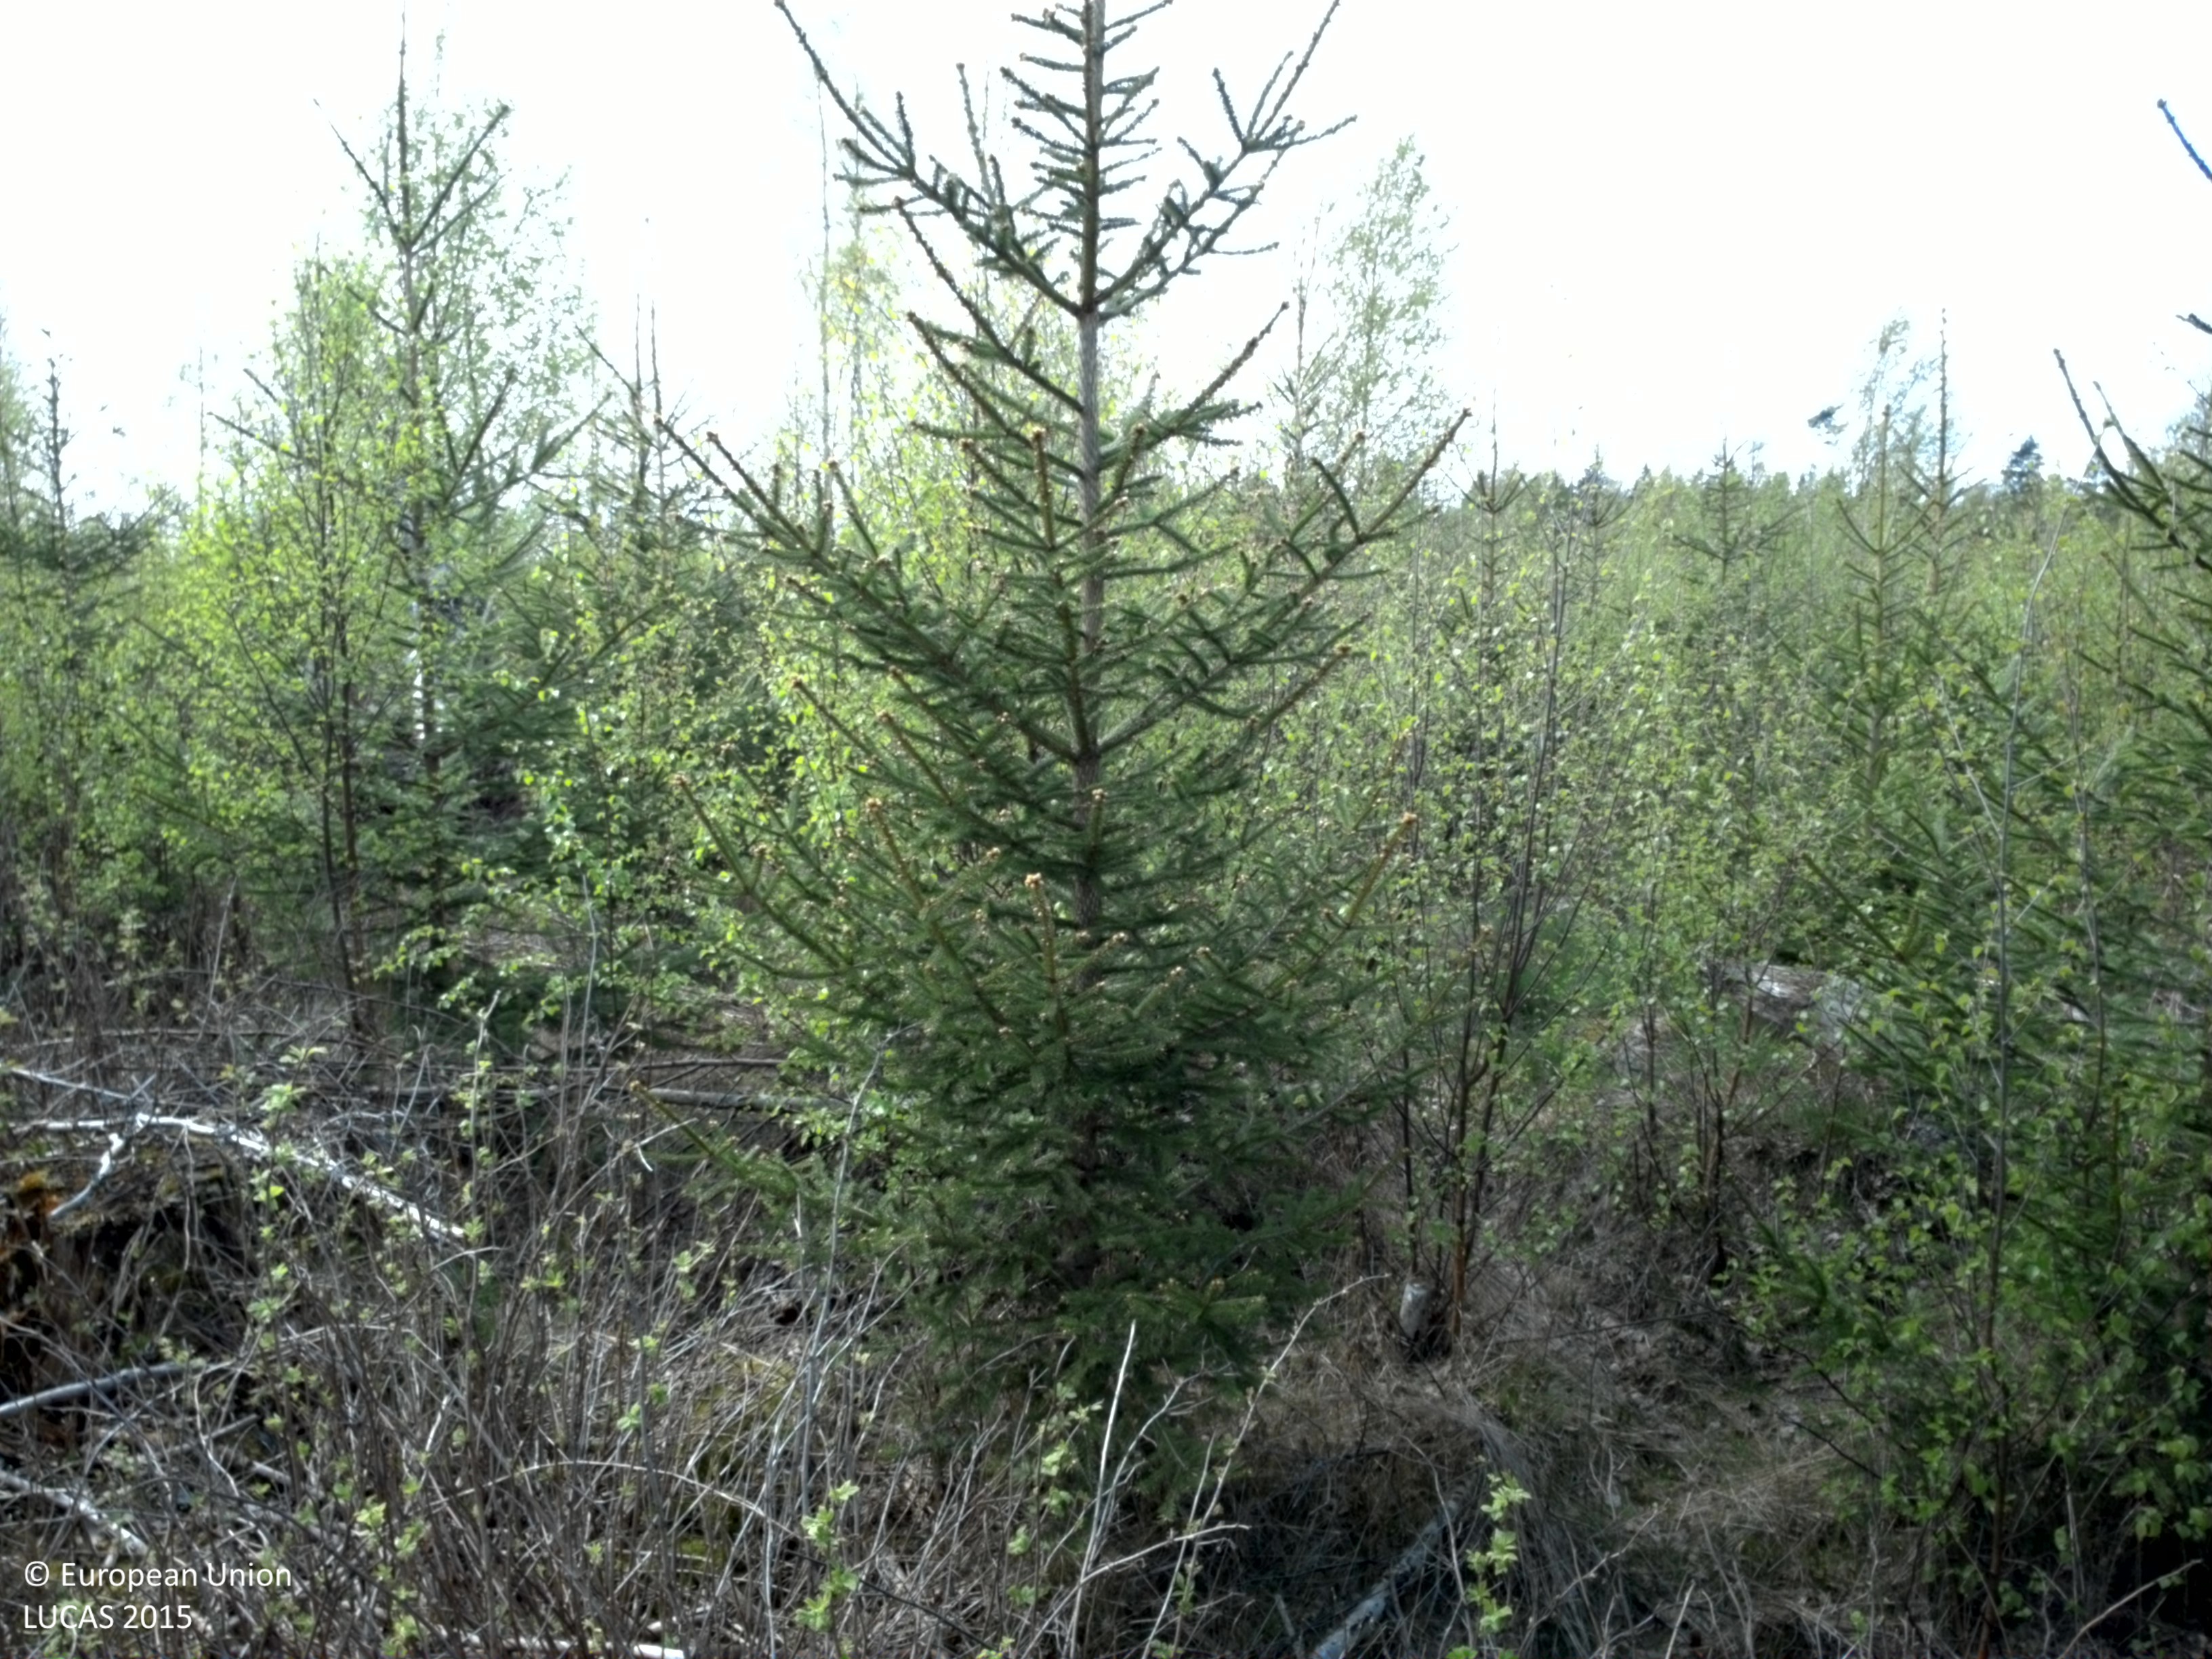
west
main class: Woodland
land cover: Spruce dominated mixed woodland
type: boreal forest
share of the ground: 50 - 75 %
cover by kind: broadleaved forest trees 40 %, coniferous forest trees 30 %, herbaceous plants 15 %, lichens and mosses 15 %
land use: Forestry
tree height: > 5 m
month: May
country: SE
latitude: 56.6931
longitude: 14.7817
